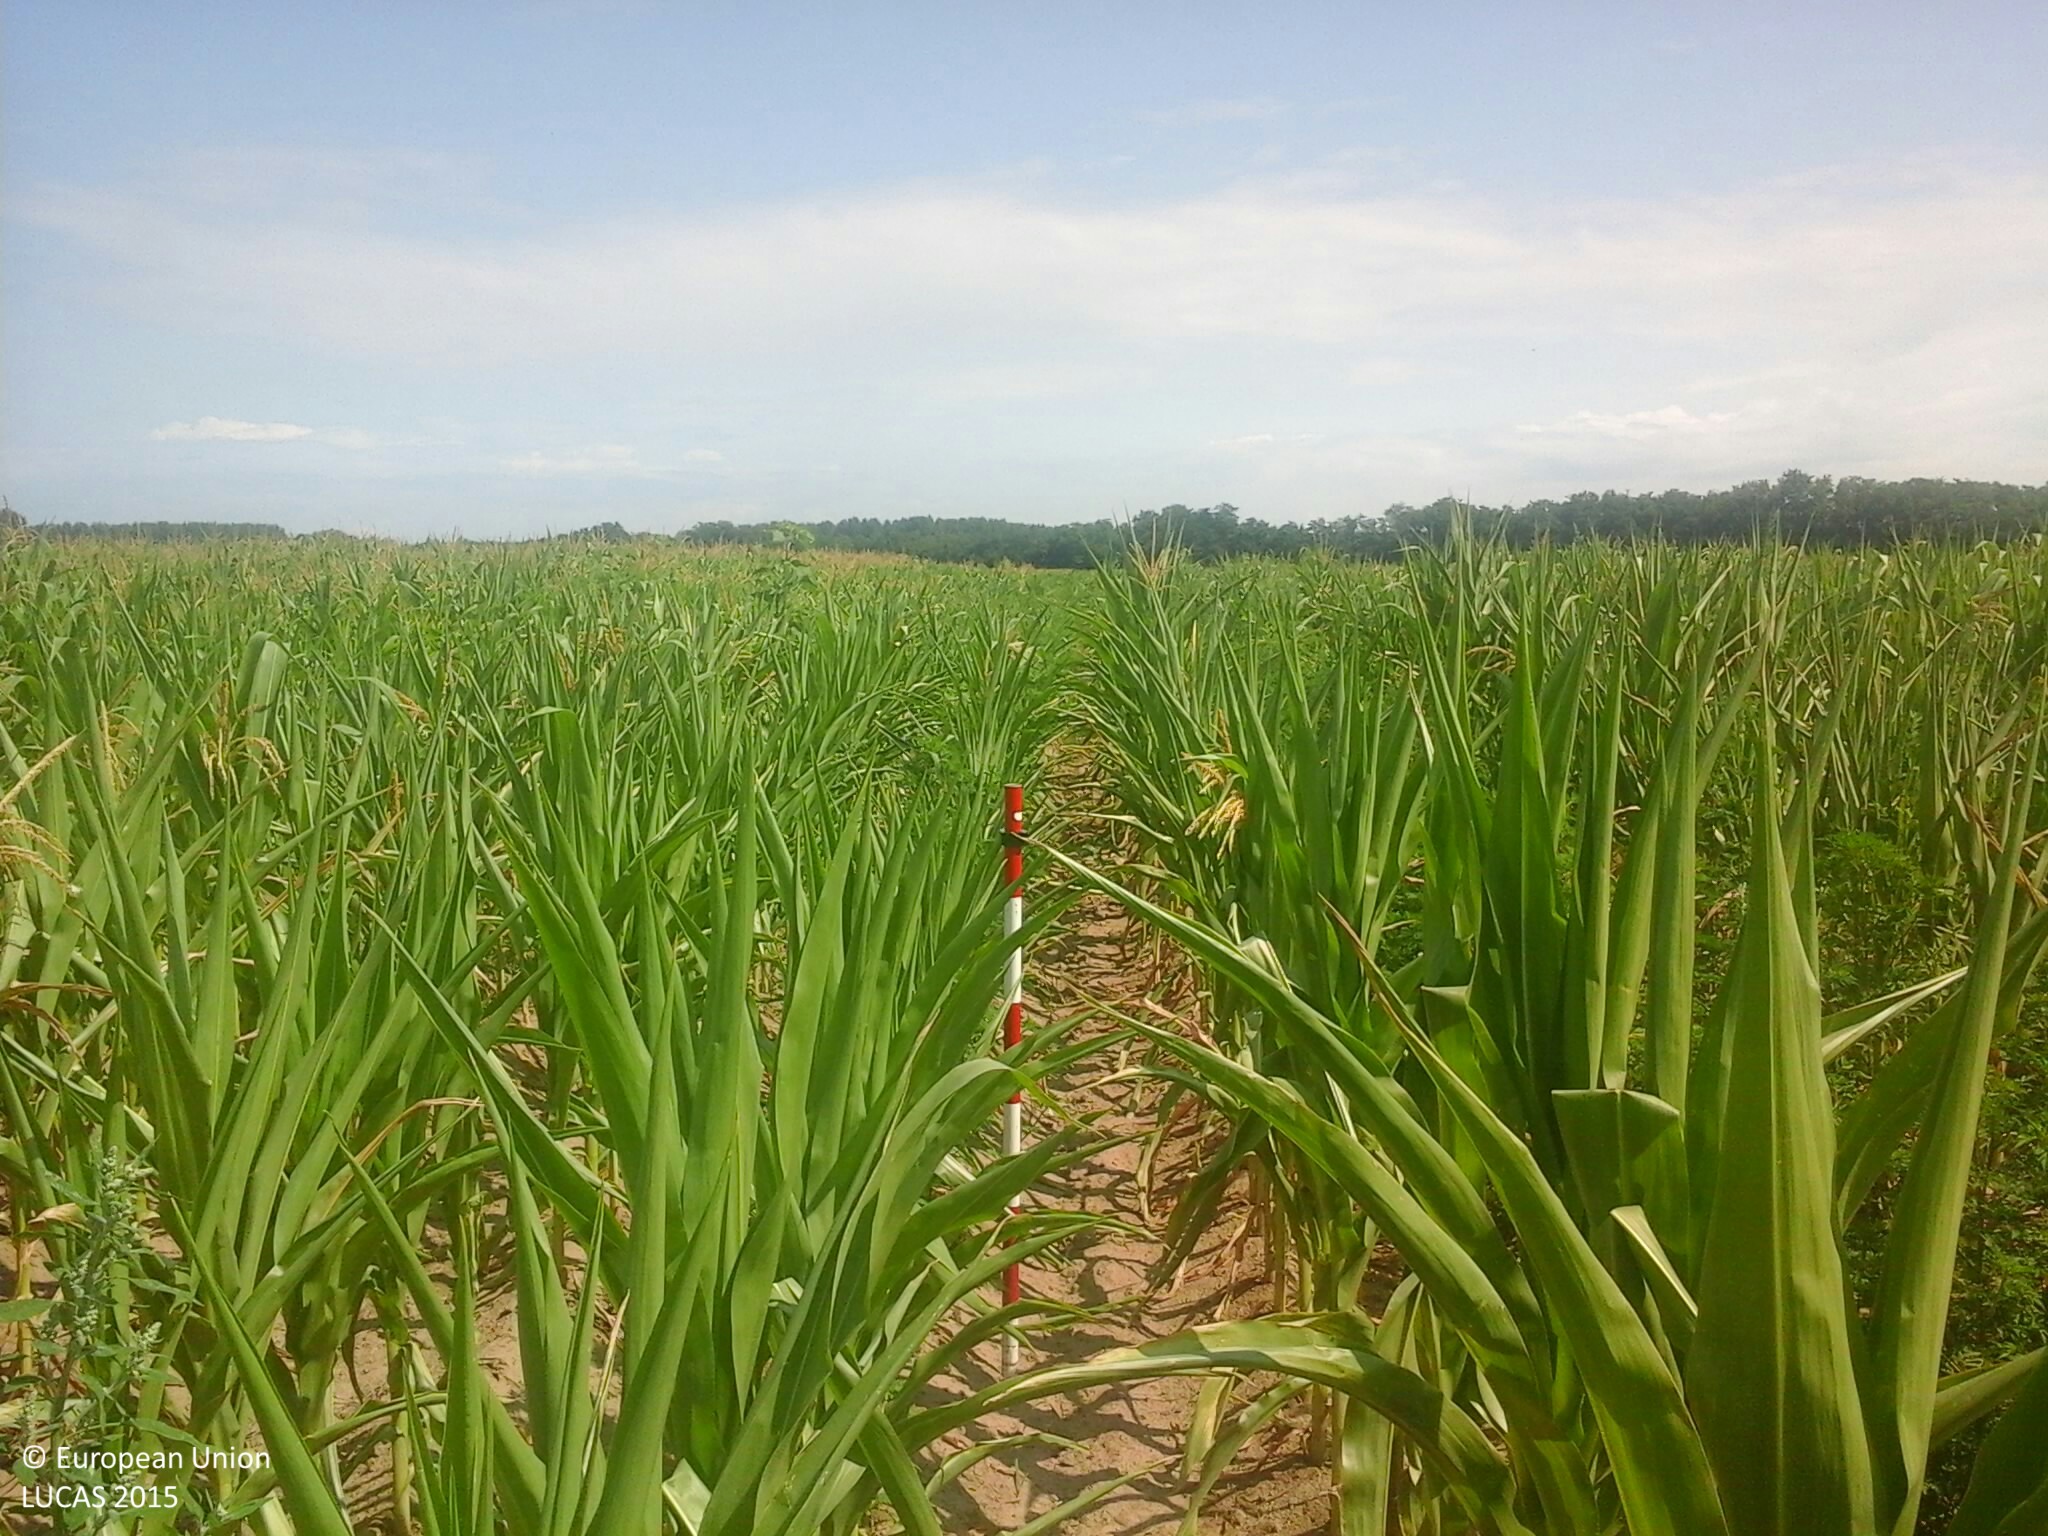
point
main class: Cropland
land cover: Maize
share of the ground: 50 - 75 %
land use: Agriculture (excluding fallow land and kitchen gardens)
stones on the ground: < 10 %
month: July
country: HU
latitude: 47.8580
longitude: 22.1498
